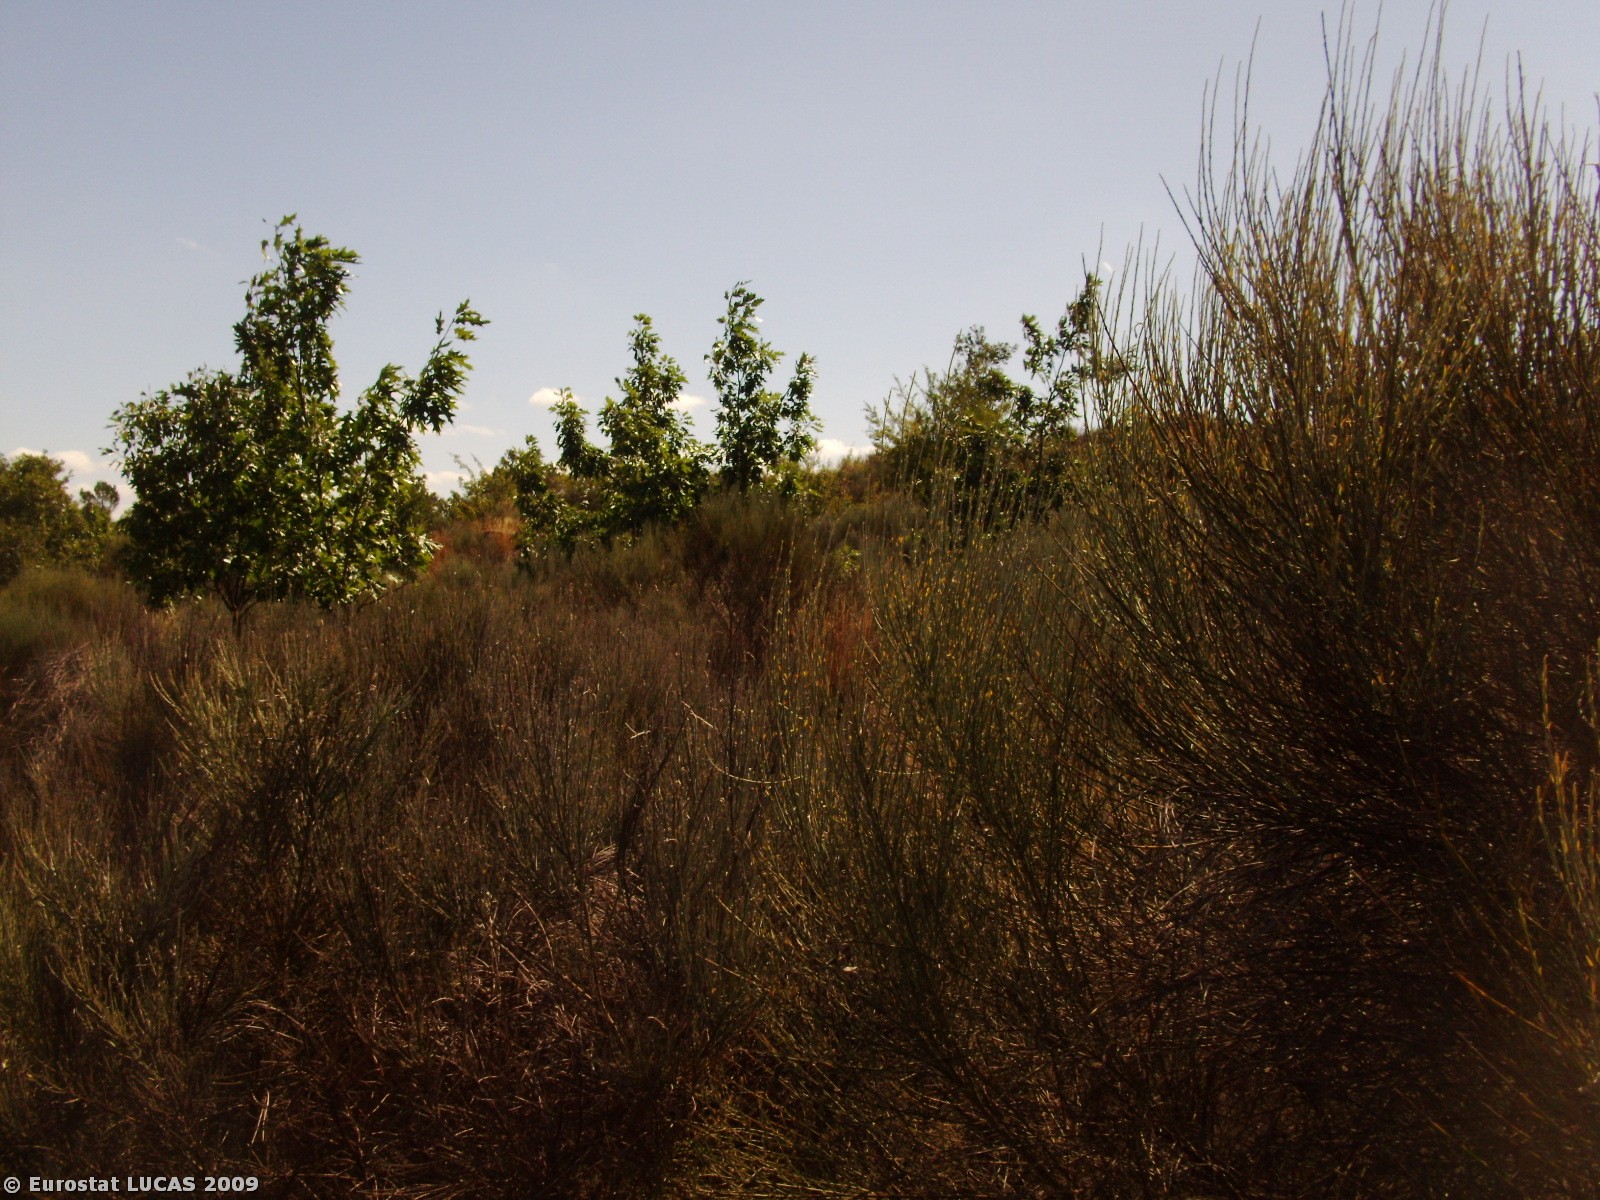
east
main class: Shrubland
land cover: Shrubland without tree cover
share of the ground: 10 - 25 %
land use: Unused
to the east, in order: Shrubland without tree cover; Broadleaved woodland; Spontaneously vegetated surfaces; Broadleaved woodland; Shrubland with sparse tree cover; Broadleaved woodland
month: July
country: PT
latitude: 40.3011
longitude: -7.3154
